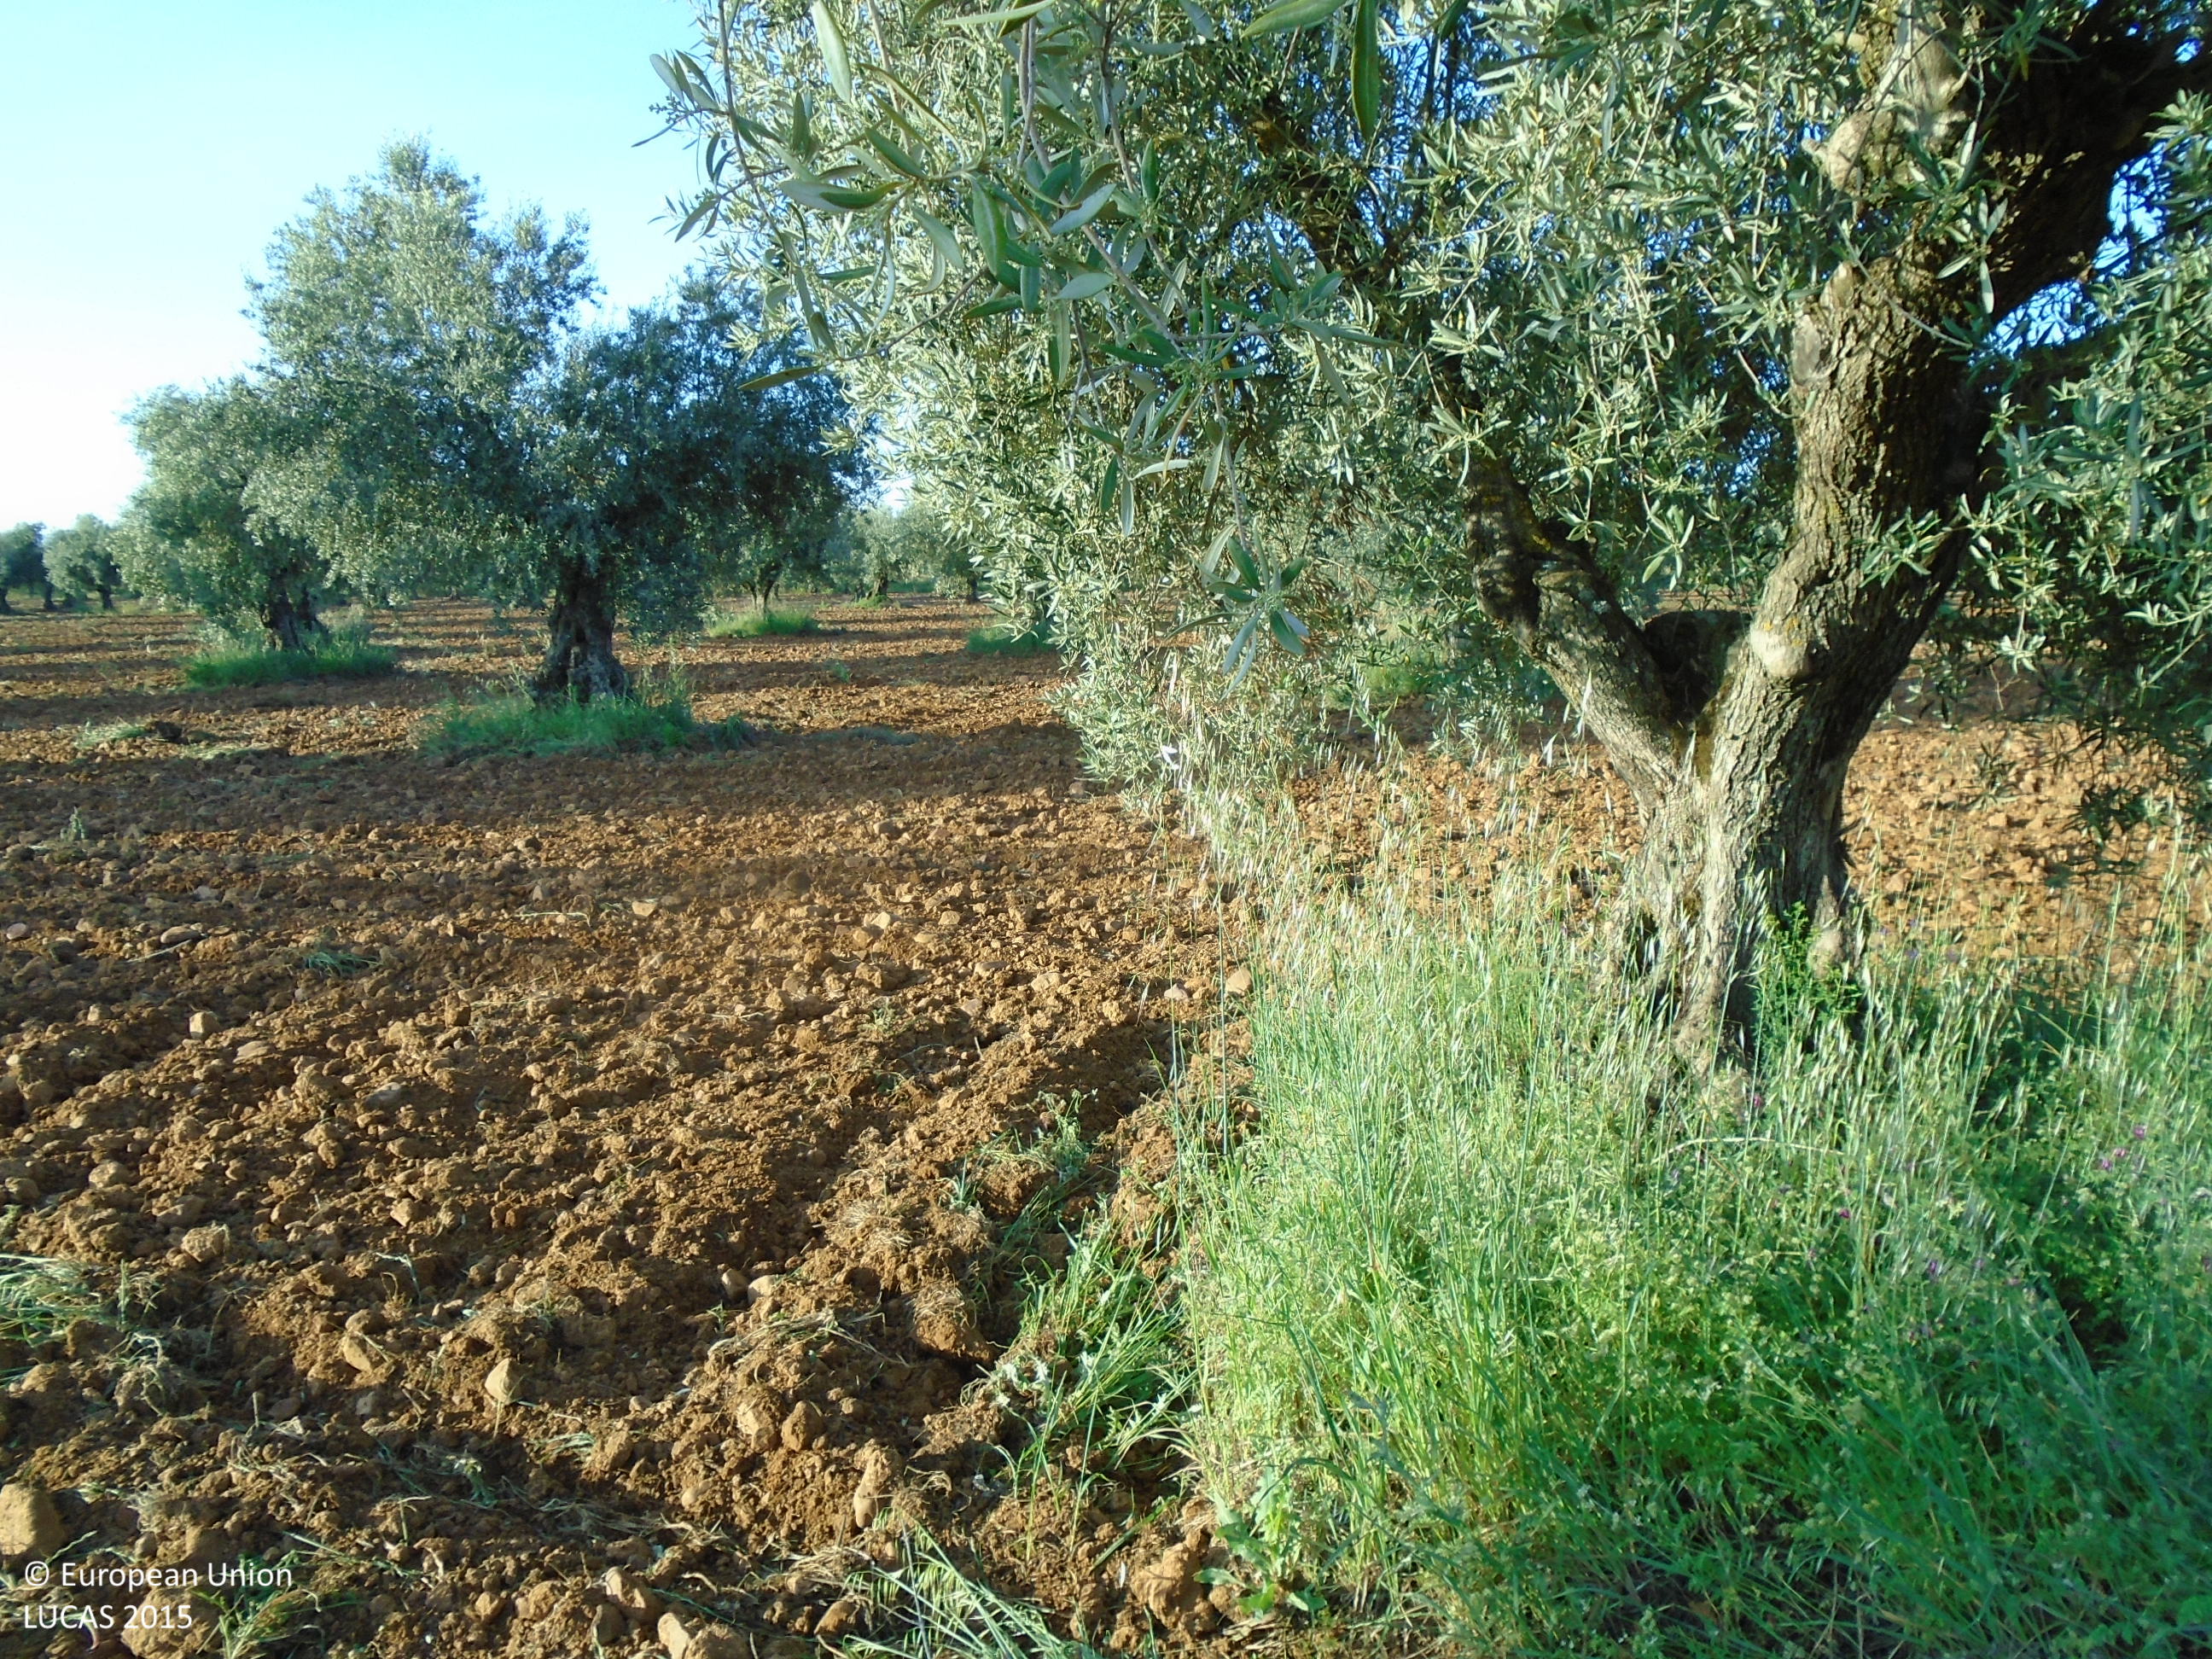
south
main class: Cropland
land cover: Olive groves
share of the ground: 10 - 25 %
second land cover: Other bare soil
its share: > 75 %
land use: Agriculture (excluding fallow land and kitchen gardens)
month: May
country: ES
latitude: 39.8100
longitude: -4.7269
